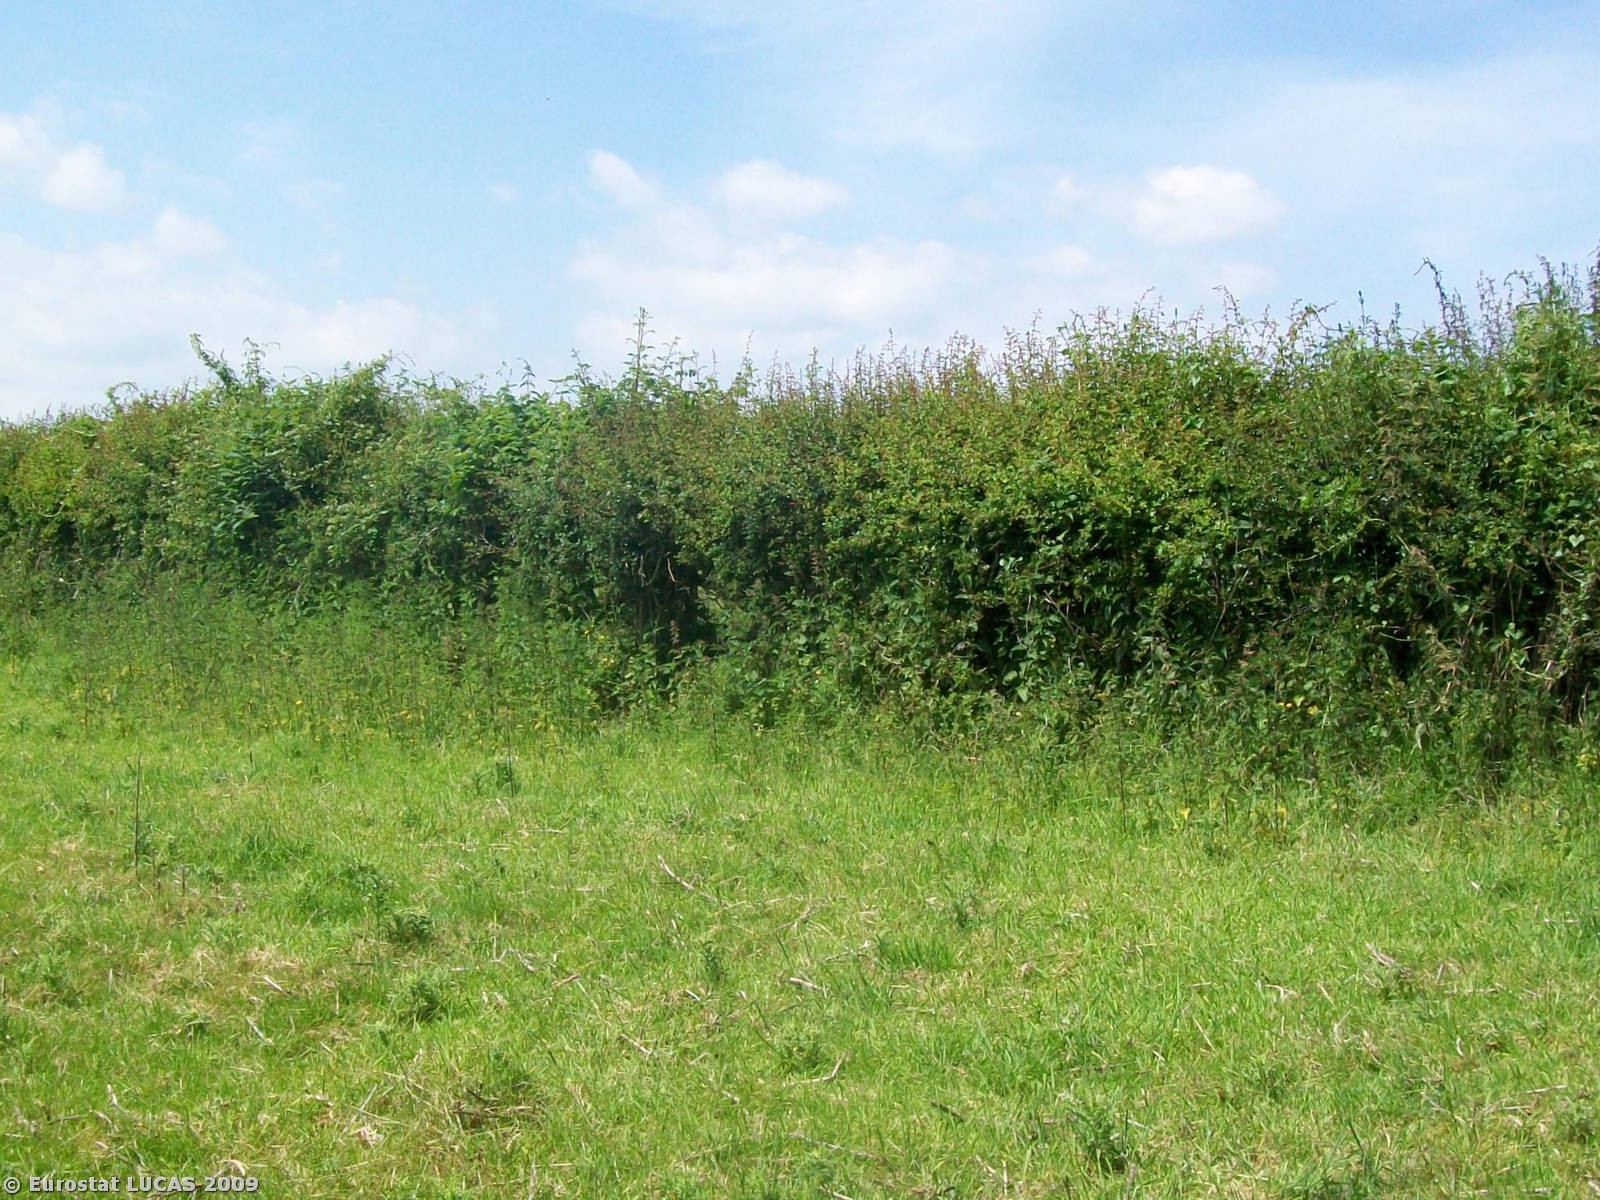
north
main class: Cropland
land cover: Barley
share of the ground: > 75 %
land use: Agriculture (excluding fallow land and kitchen gardens)
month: June
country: GB
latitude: 52.1496
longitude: -3.0093
